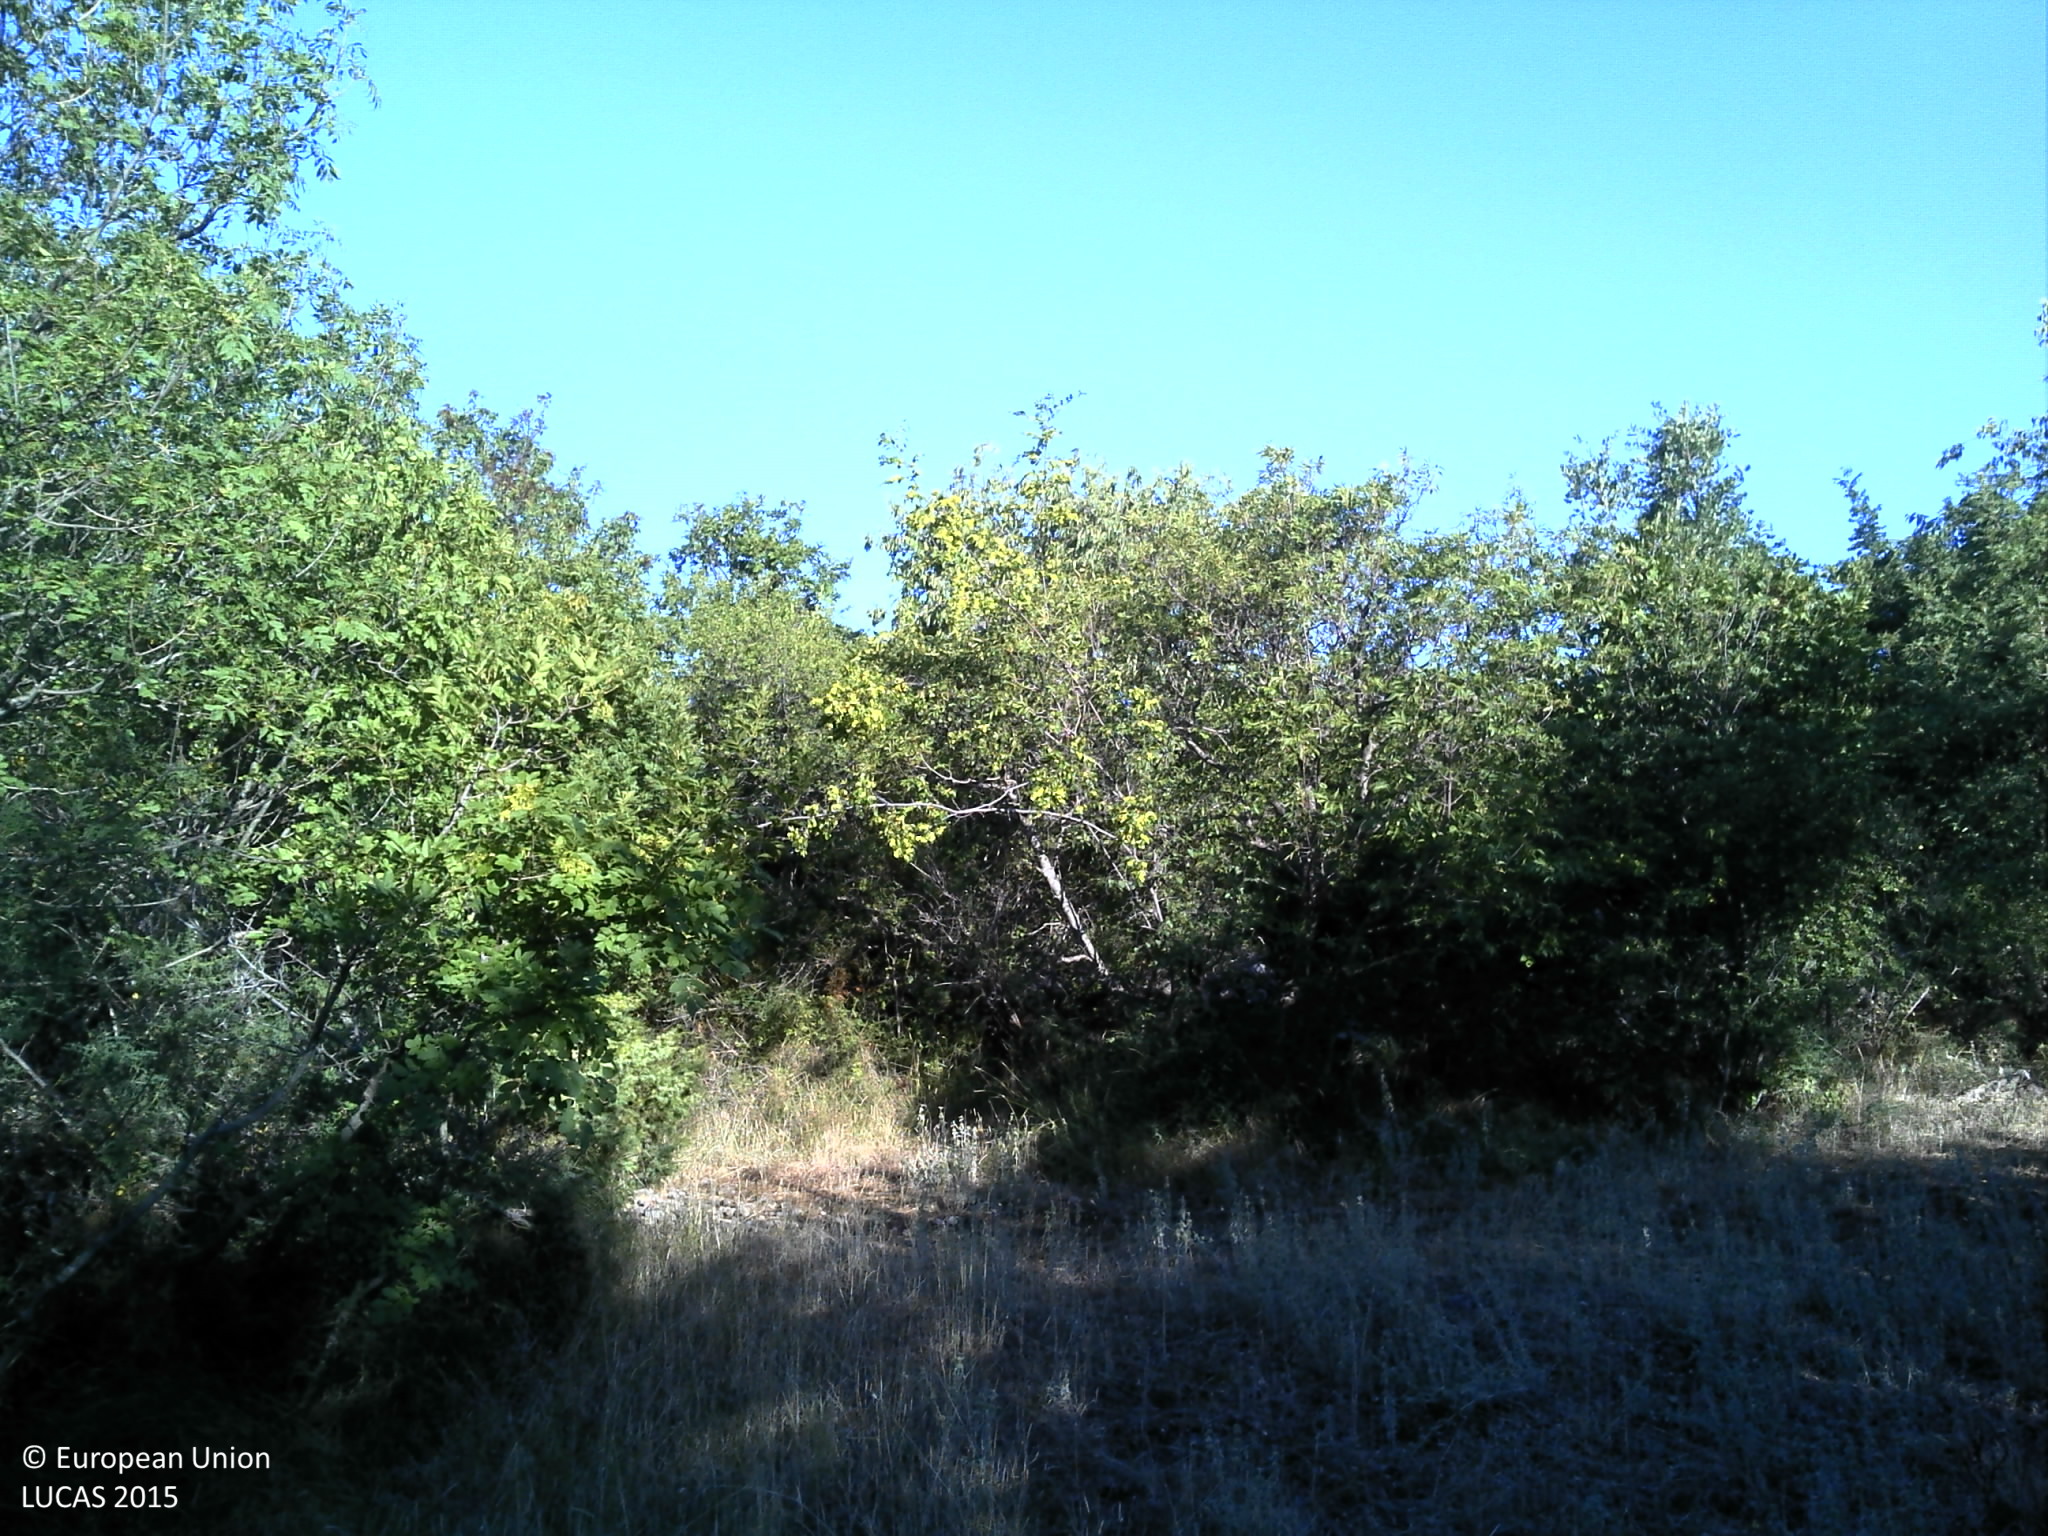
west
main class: Woodland
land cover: Broadleaved woodland
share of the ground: 25 - 50 %
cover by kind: broadleaved forest trees 40 %, shrubs 30 %, herbaceous plants 30 %
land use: Semi-natural and natural areas not in use
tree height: > 5 m
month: July
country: HR
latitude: 44.0807
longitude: 16.0991
